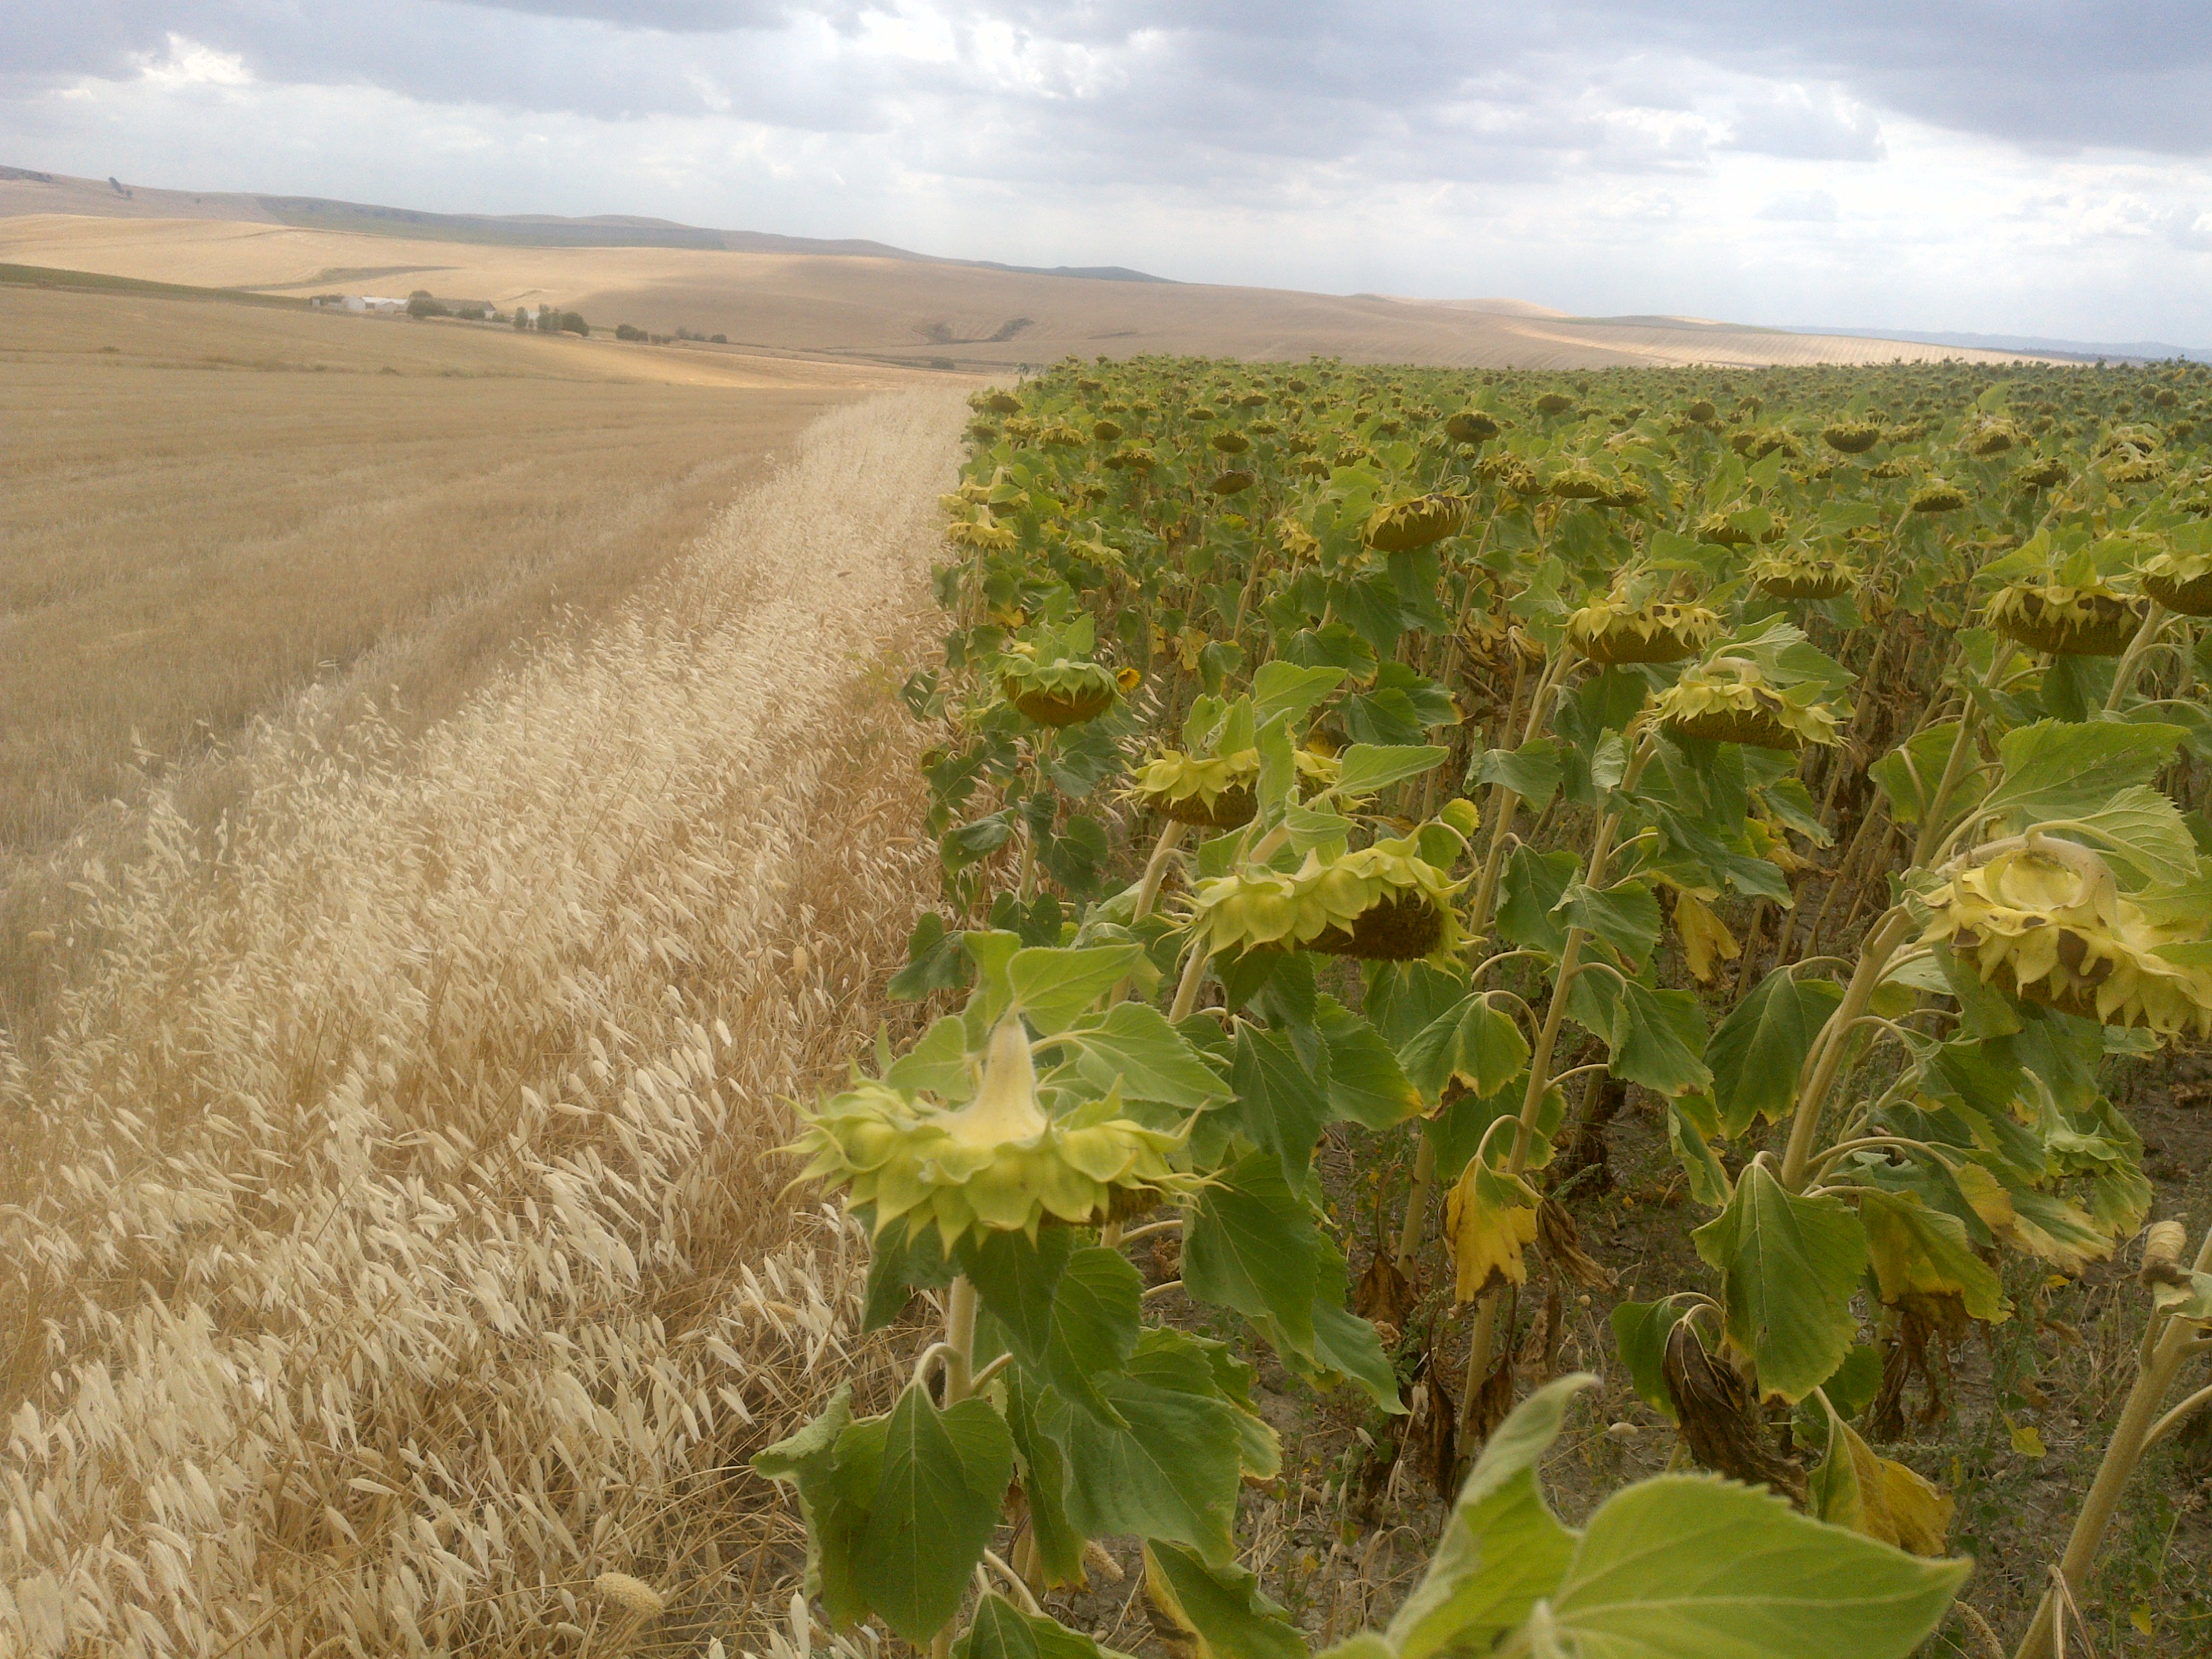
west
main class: Cropland
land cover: Sunflower
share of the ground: > 75 %
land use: Agriculture (excluding fallow land and kitchen gardens)
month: June
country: ES
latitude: 37.8009
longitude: -4.5358
